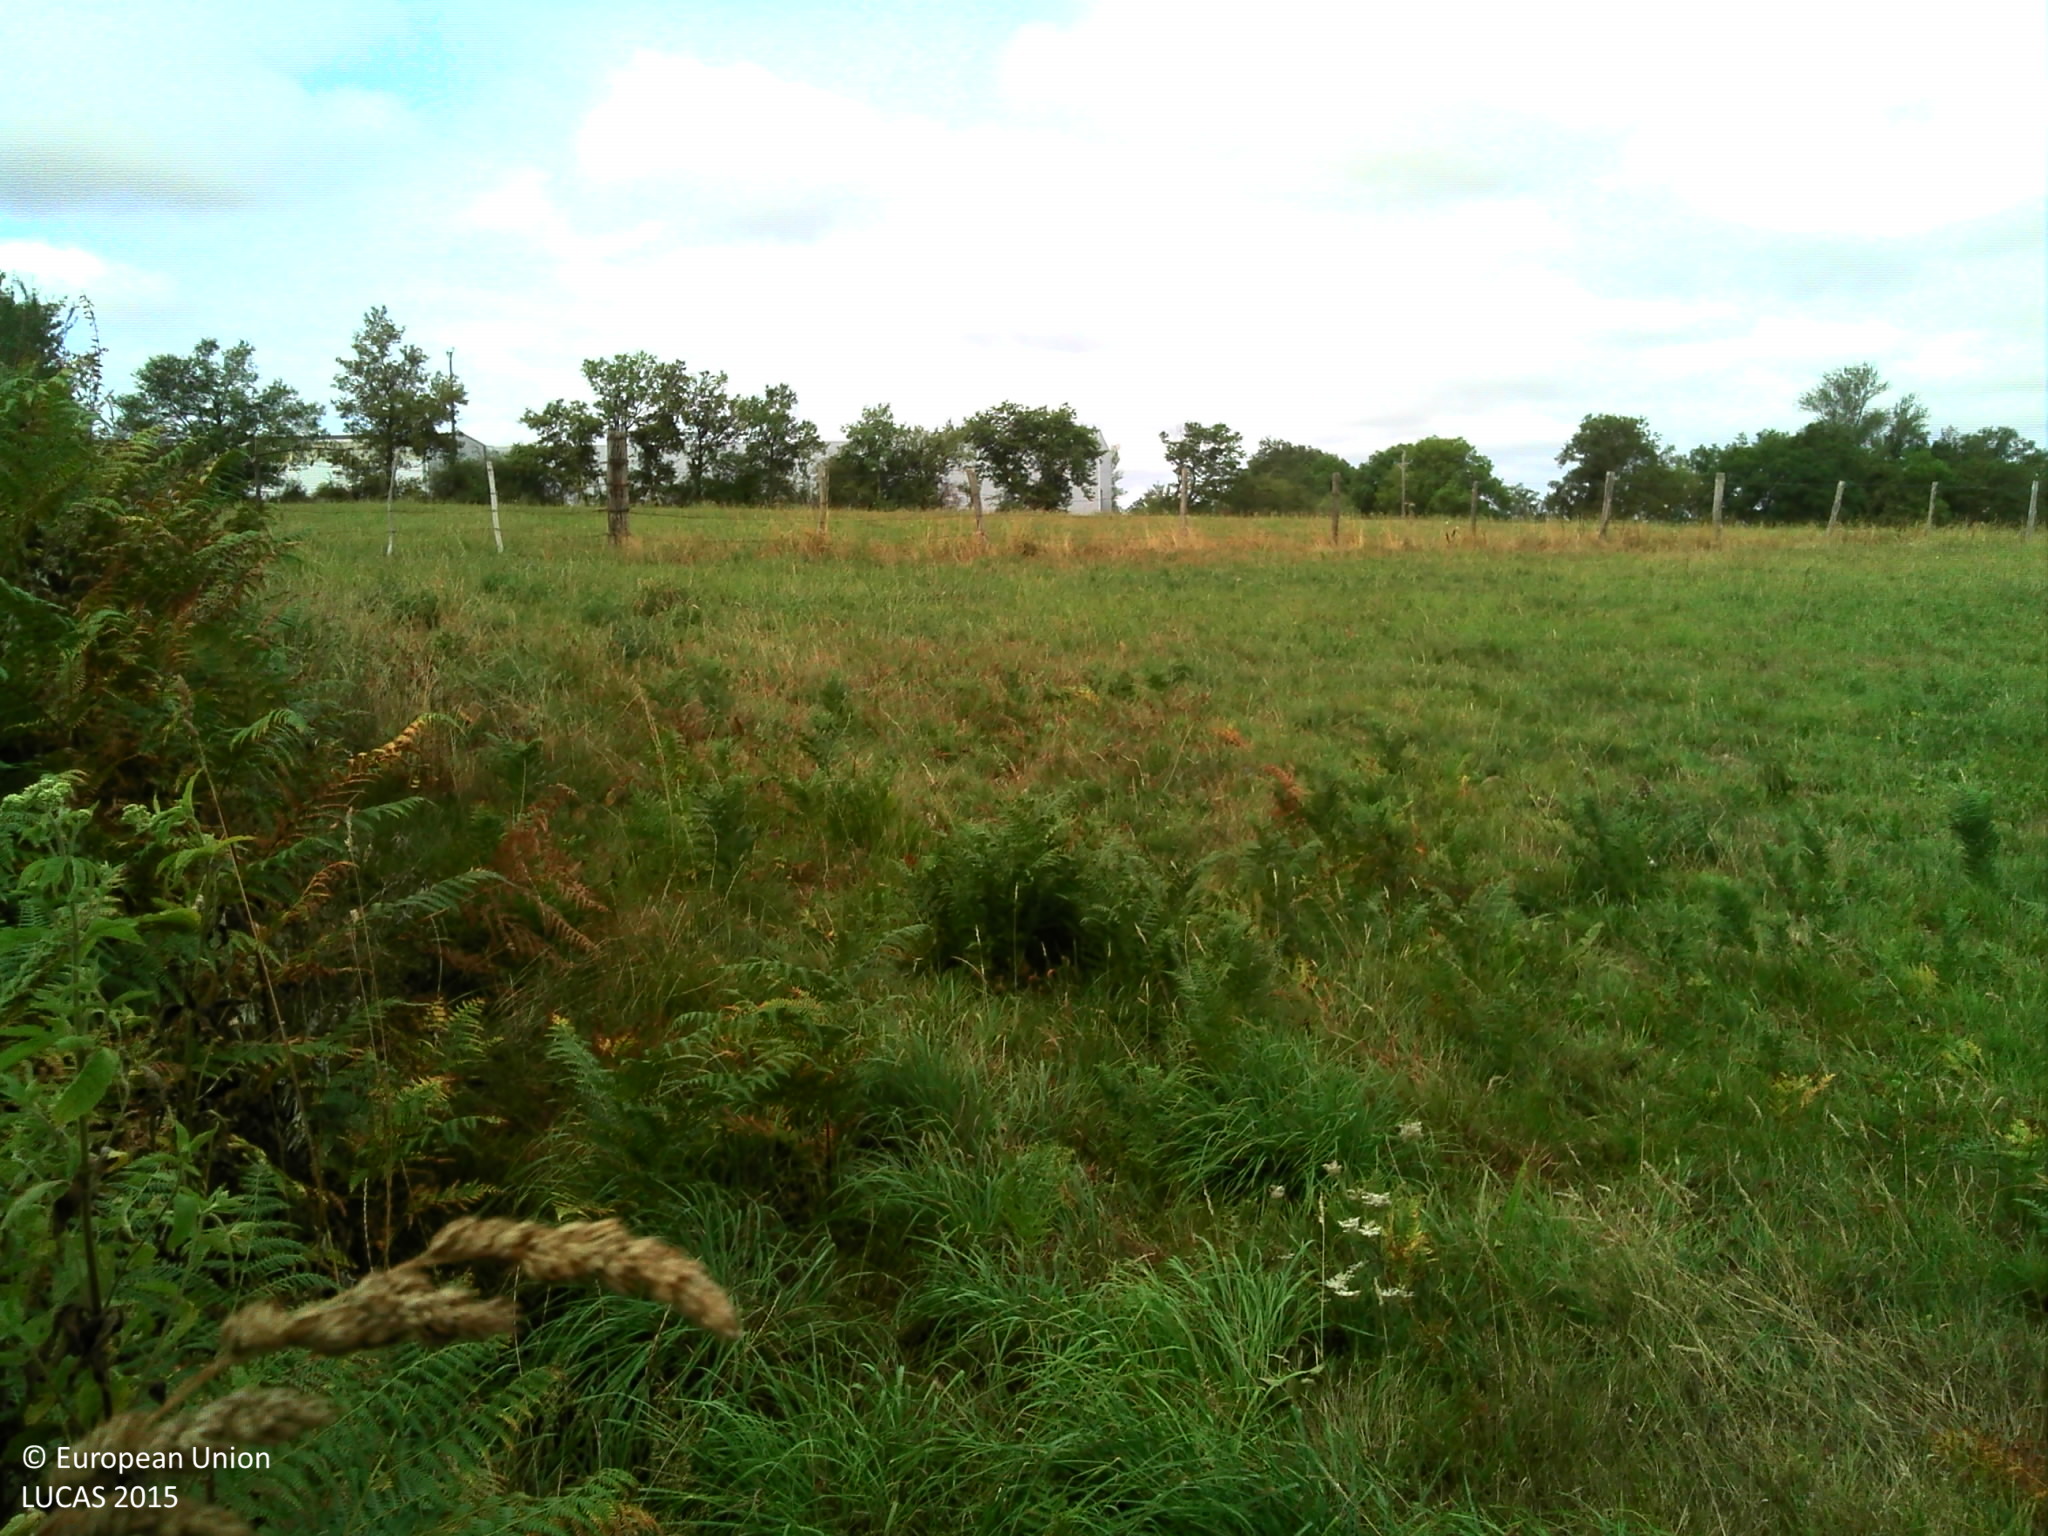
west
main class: Grassland
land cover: Grassland without tree/shrub cover
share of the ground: > 75 %
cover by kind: herbaceous plants 100 %
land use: Agriculture (excluding fallow land and kitchen gardens)
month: July
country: FR
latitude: 44.0448
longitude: 2.5289
